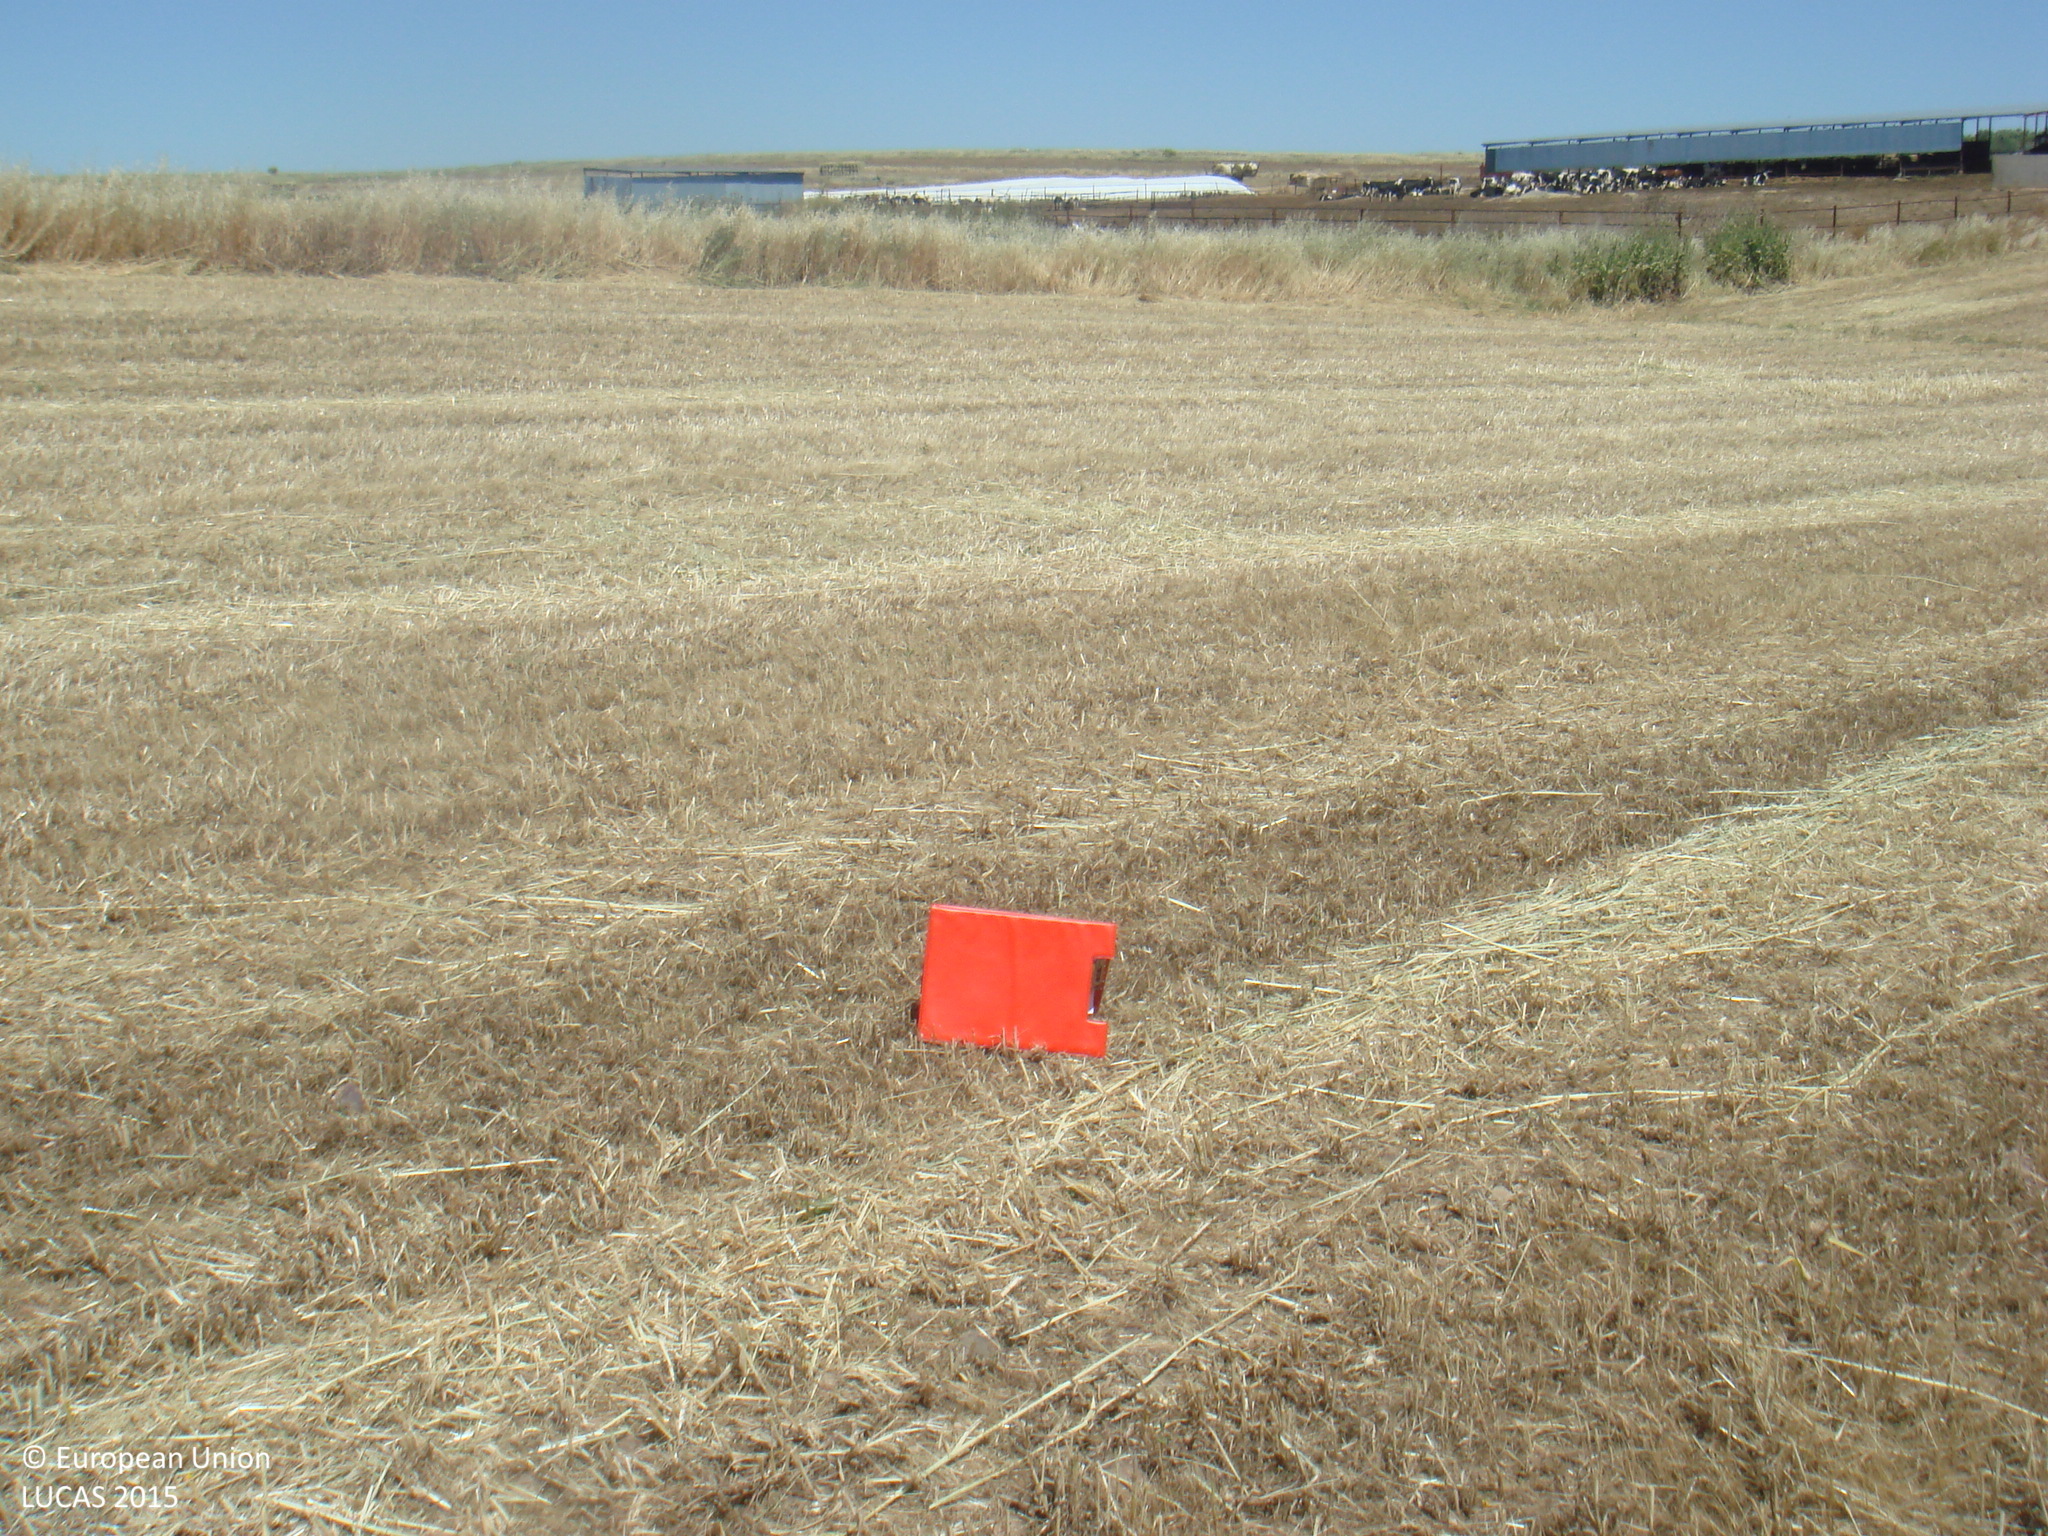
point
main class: Cropland
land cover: Barley
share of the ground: > 75 %
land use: Agriculture (excluding fallow land and kitchen gardens)
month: May
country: ES
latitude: 38.5691
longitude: -5.1466
